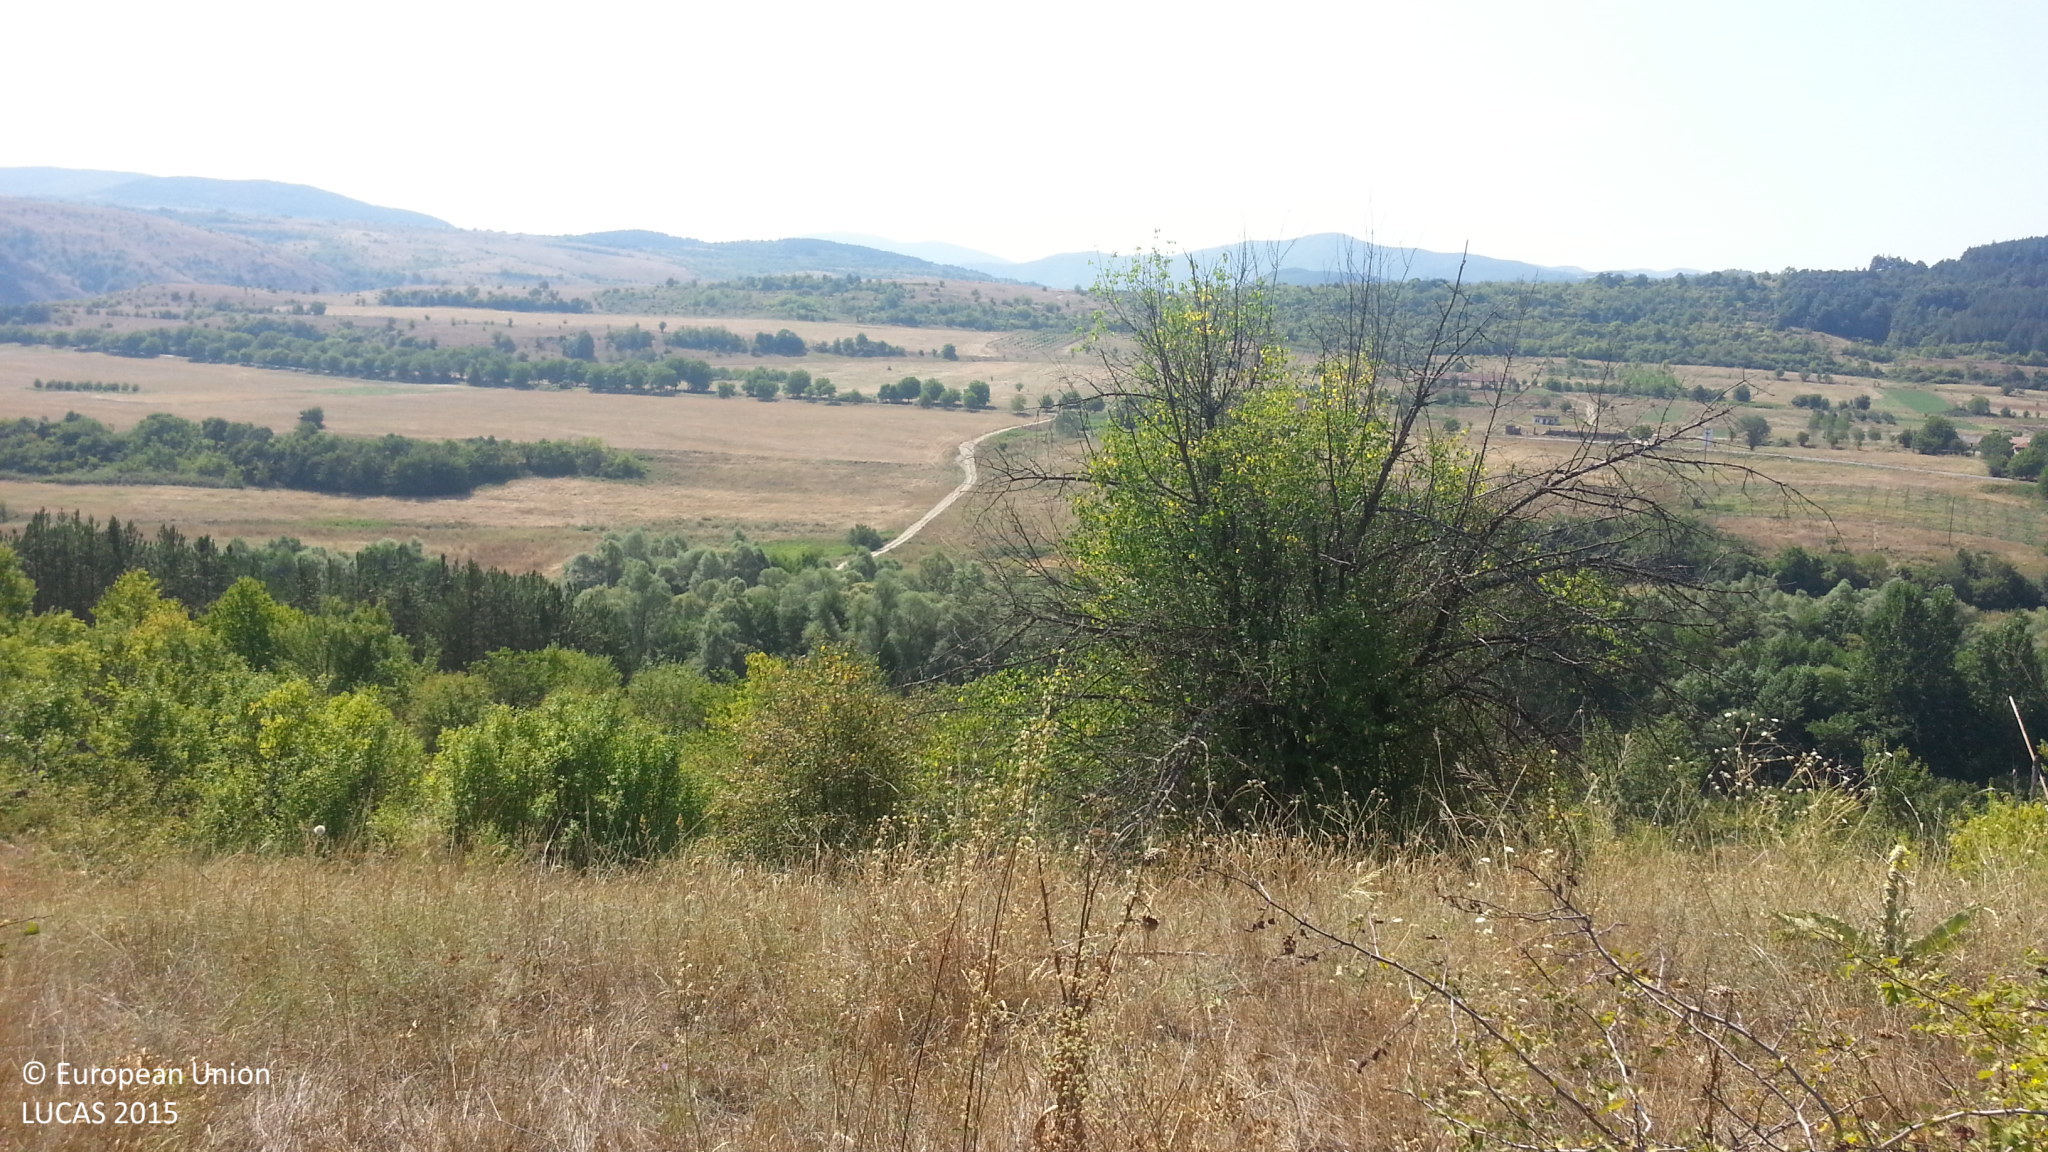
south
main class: Grassland
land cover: Grassland with sparse tree/shrub cover
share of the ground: > 75 %
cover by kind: herbaceous plants 85 %, shrubs 10 %, broadleaved forest trees 5 %
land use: Abandoned areas
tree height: < 5 m
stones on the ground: 10 - 25 %
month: August
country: BG
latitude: 42.2476
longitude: 22.8830
